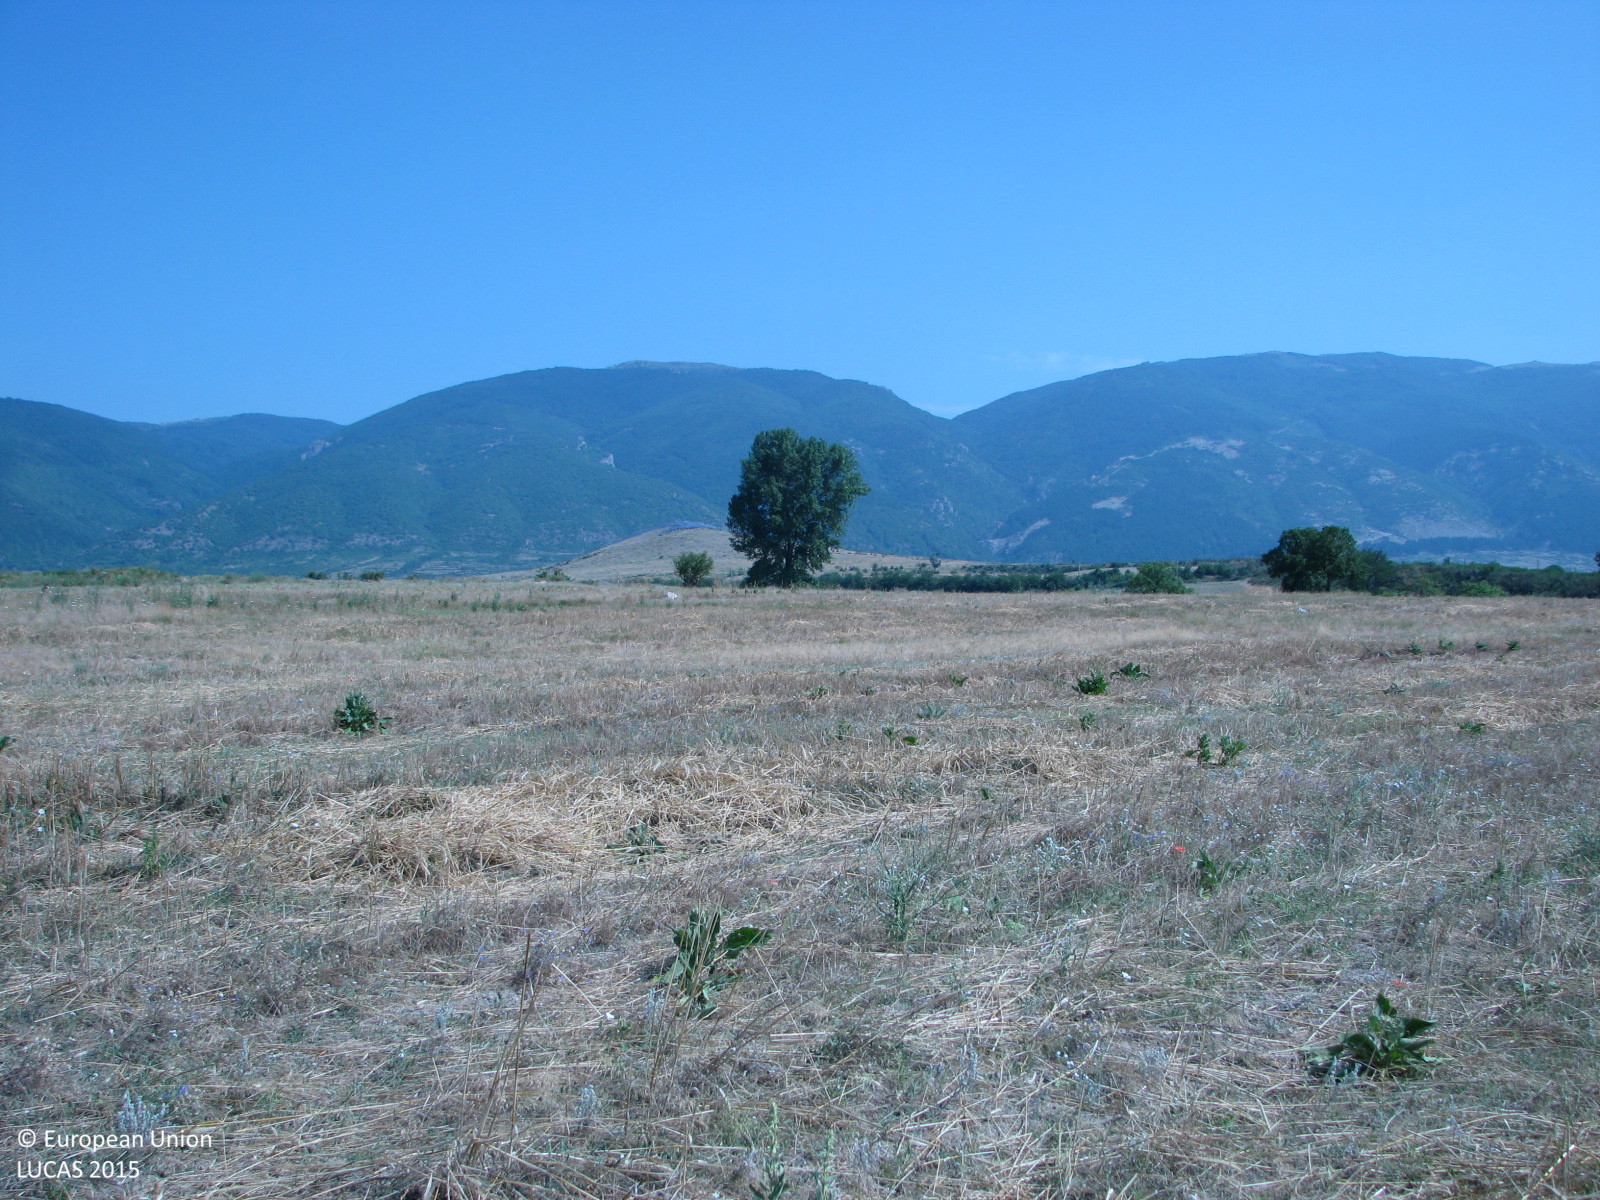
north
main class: Cropland
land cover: Rye
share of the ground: > 75 %
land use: Agriculture (excluding fallow land and kitchen gardens)
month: July
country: BG
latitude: 42.6657
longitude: 25.9551
